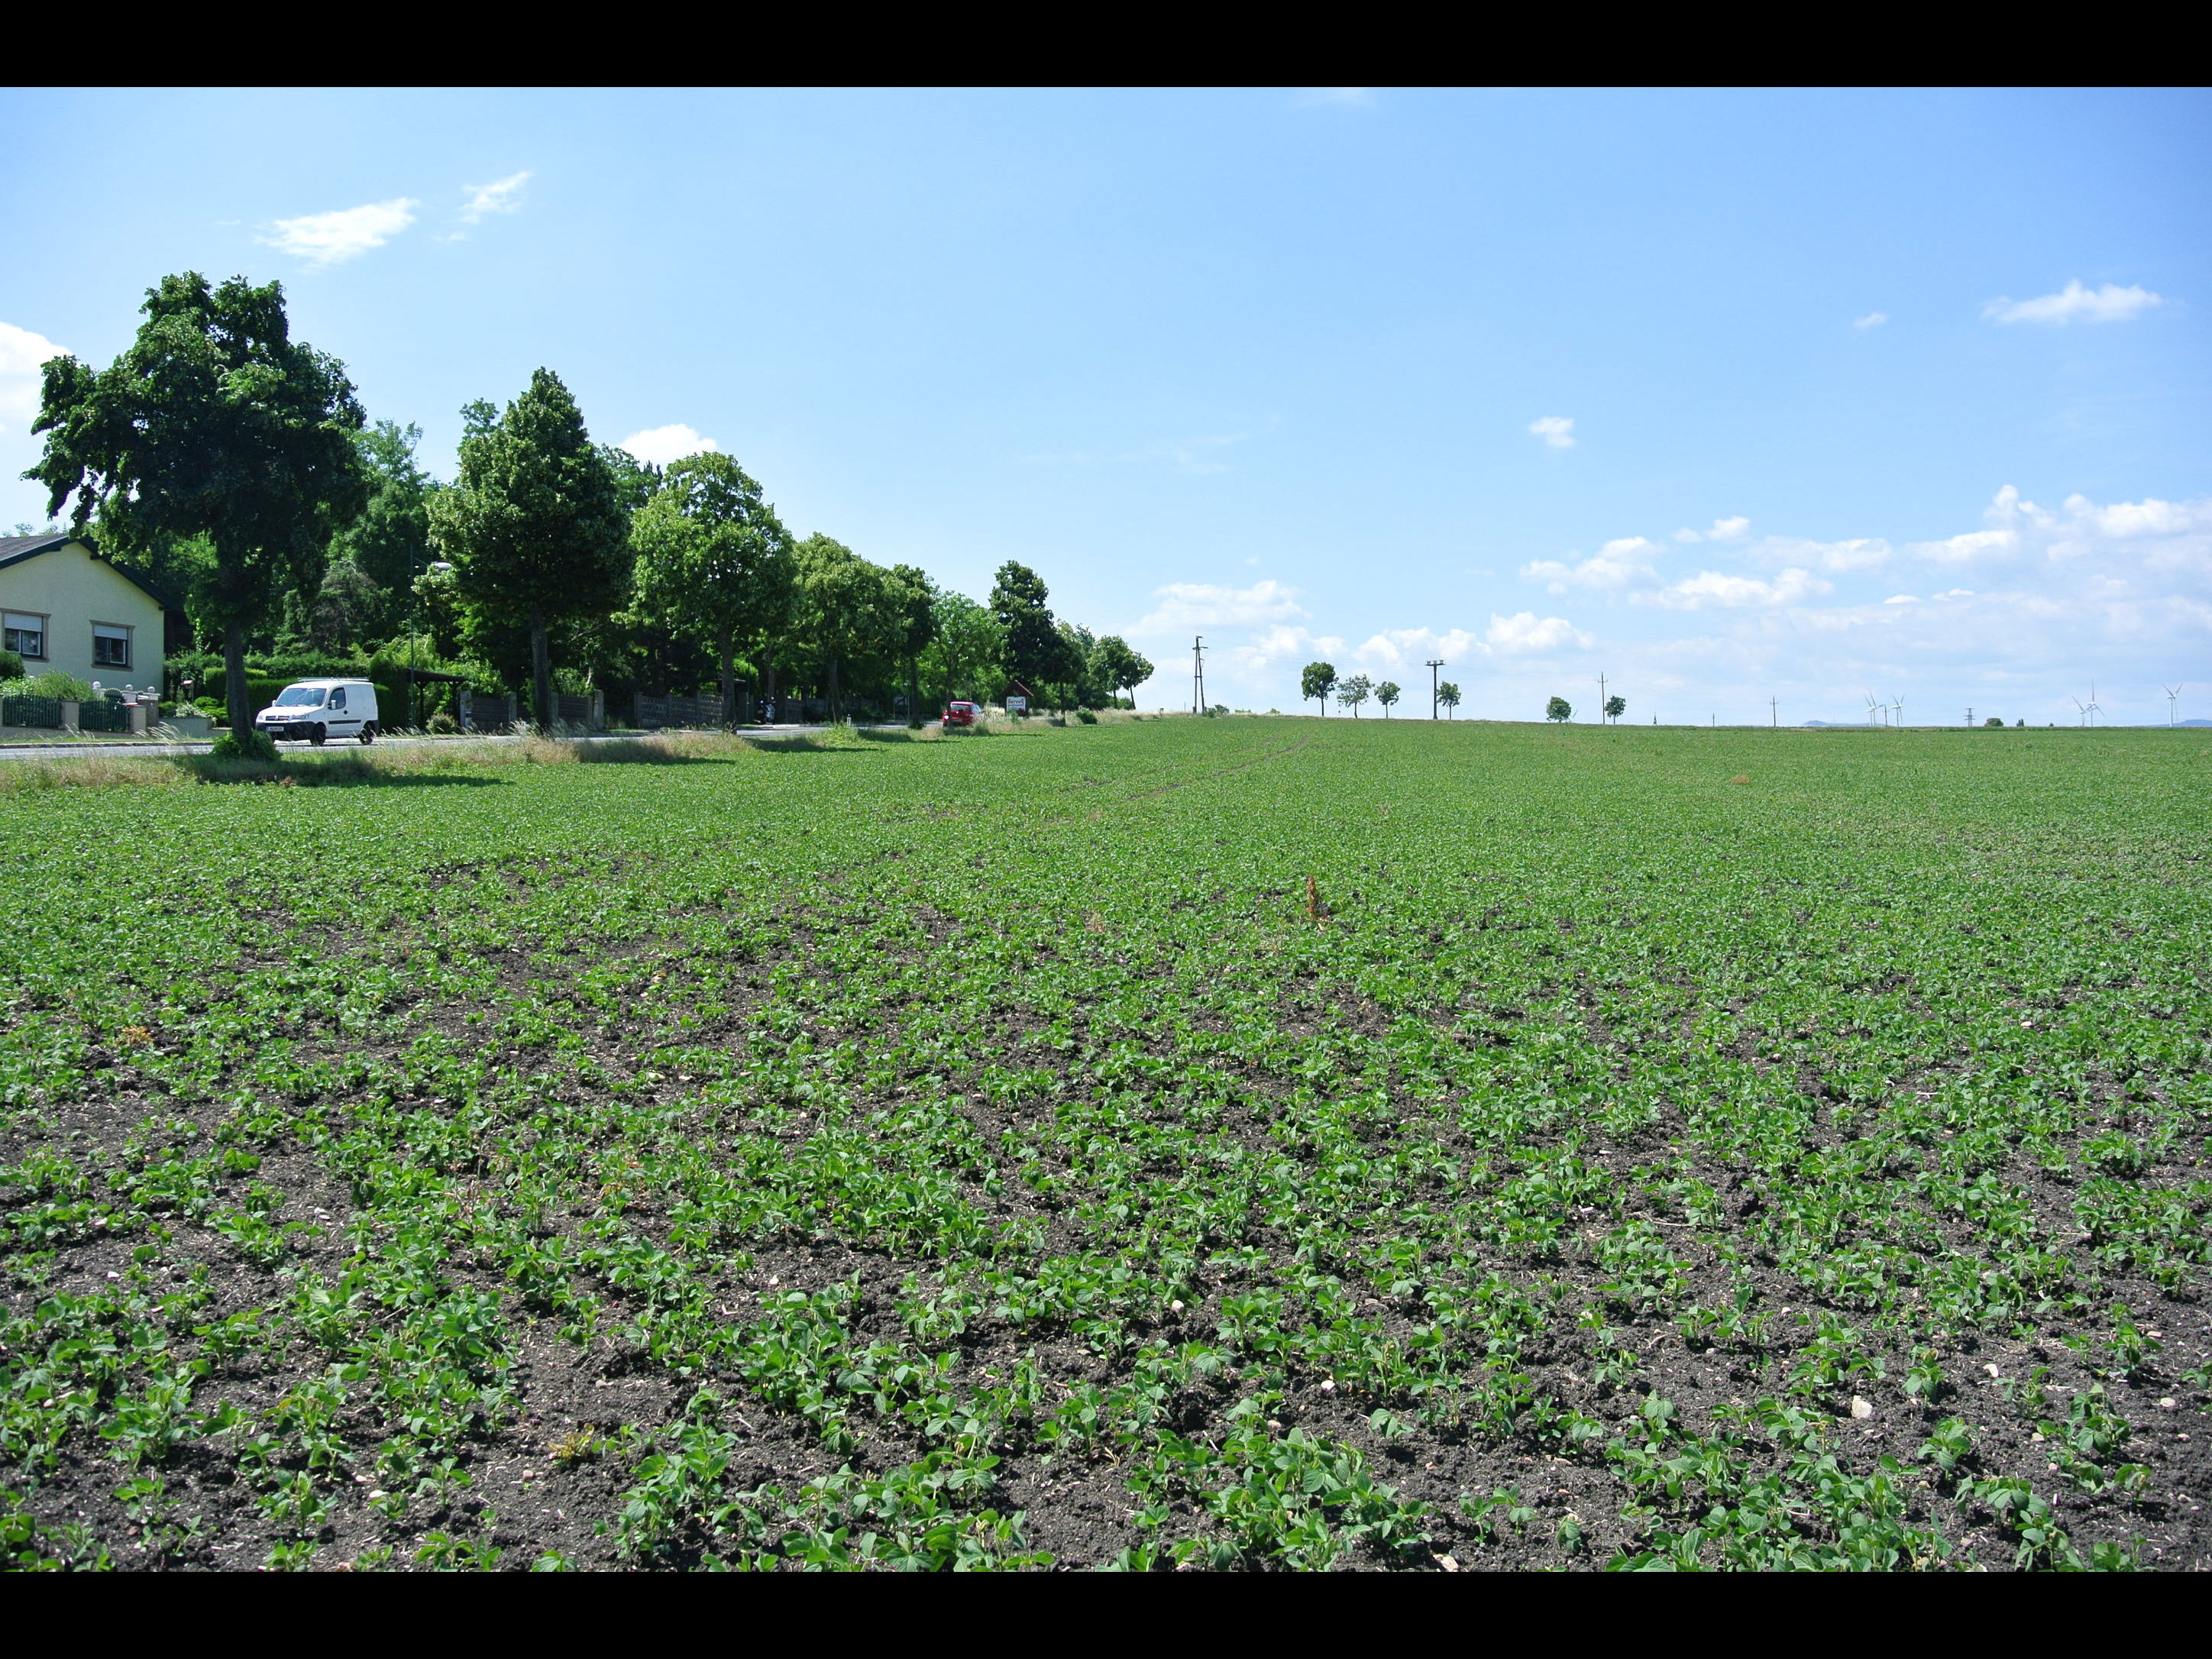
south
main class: Cropland
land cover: Soya
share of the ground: > 75 %
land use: Agriculture (excluding fallow land and kitchen gardens)
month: June
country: AT
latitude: 47.7818
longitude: 16.4507
